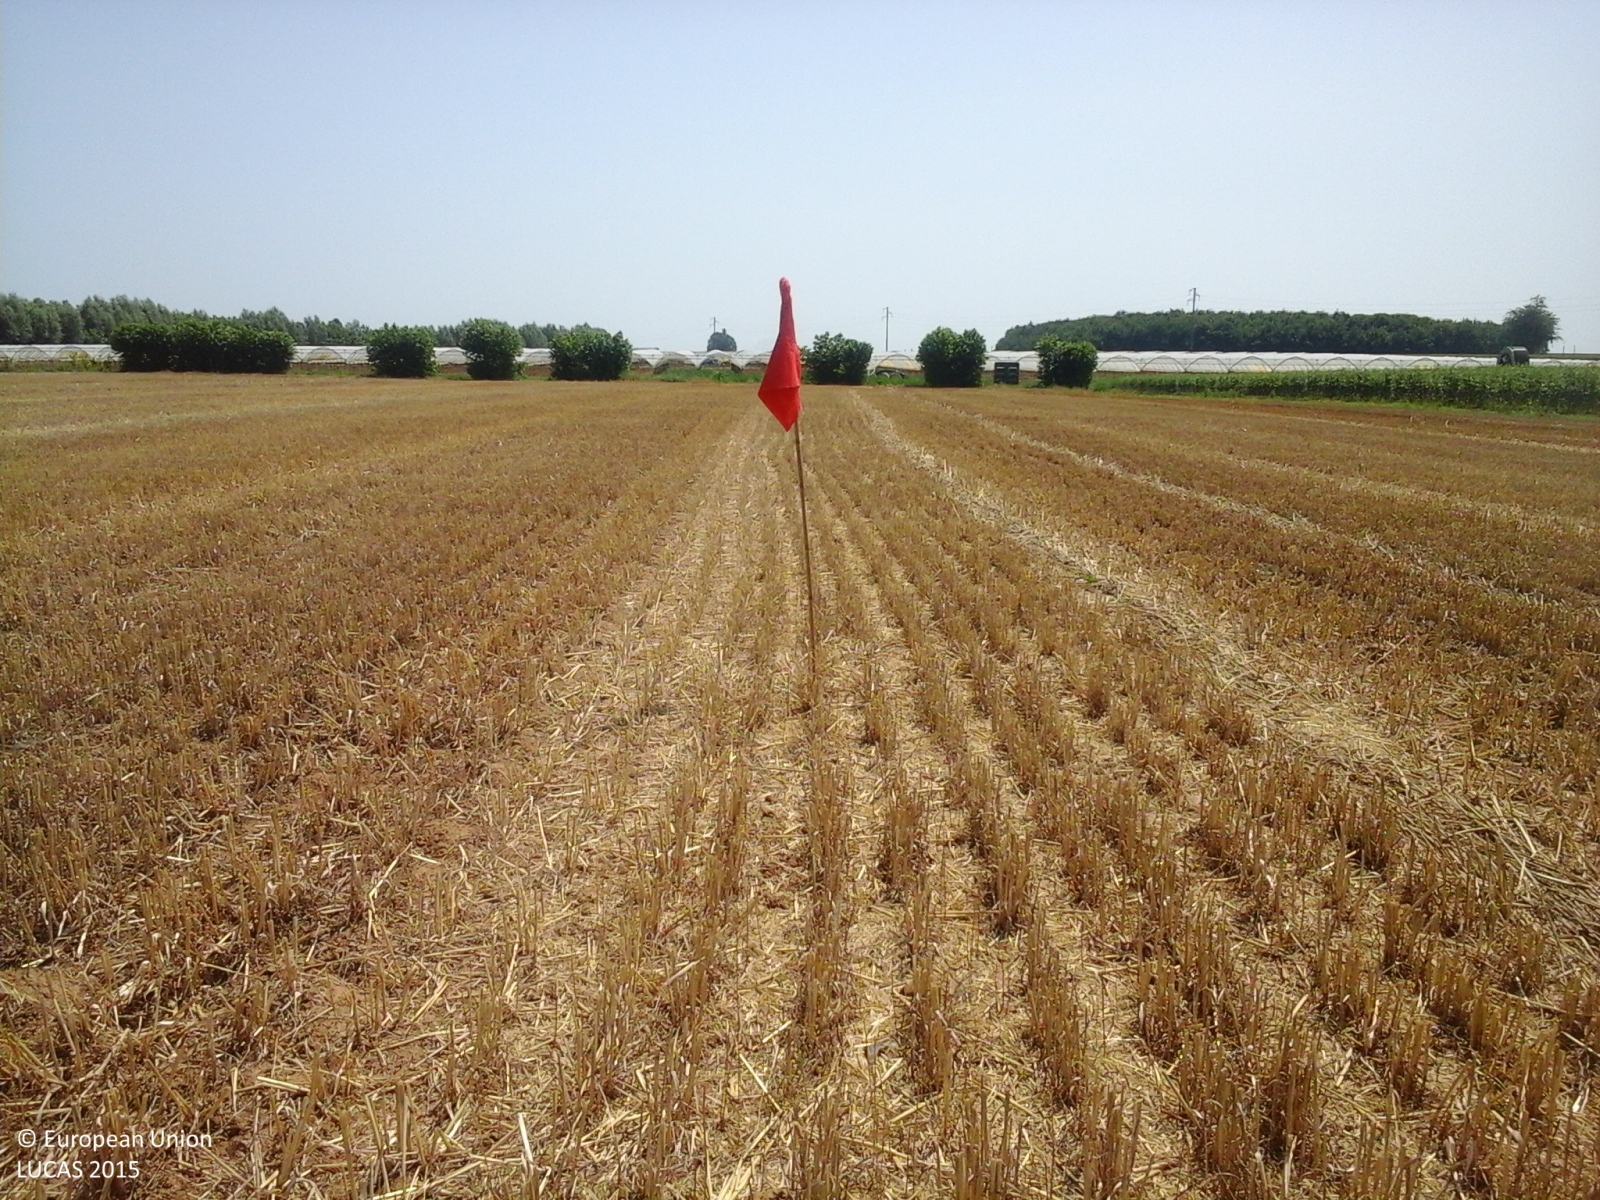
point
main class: Cropland
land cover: Common wheat
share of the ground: > 75 %
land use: Agriculture (excluding fallow land and kitchen gardens)
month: July
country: IT
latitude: 45.2658
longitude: 10.9541
